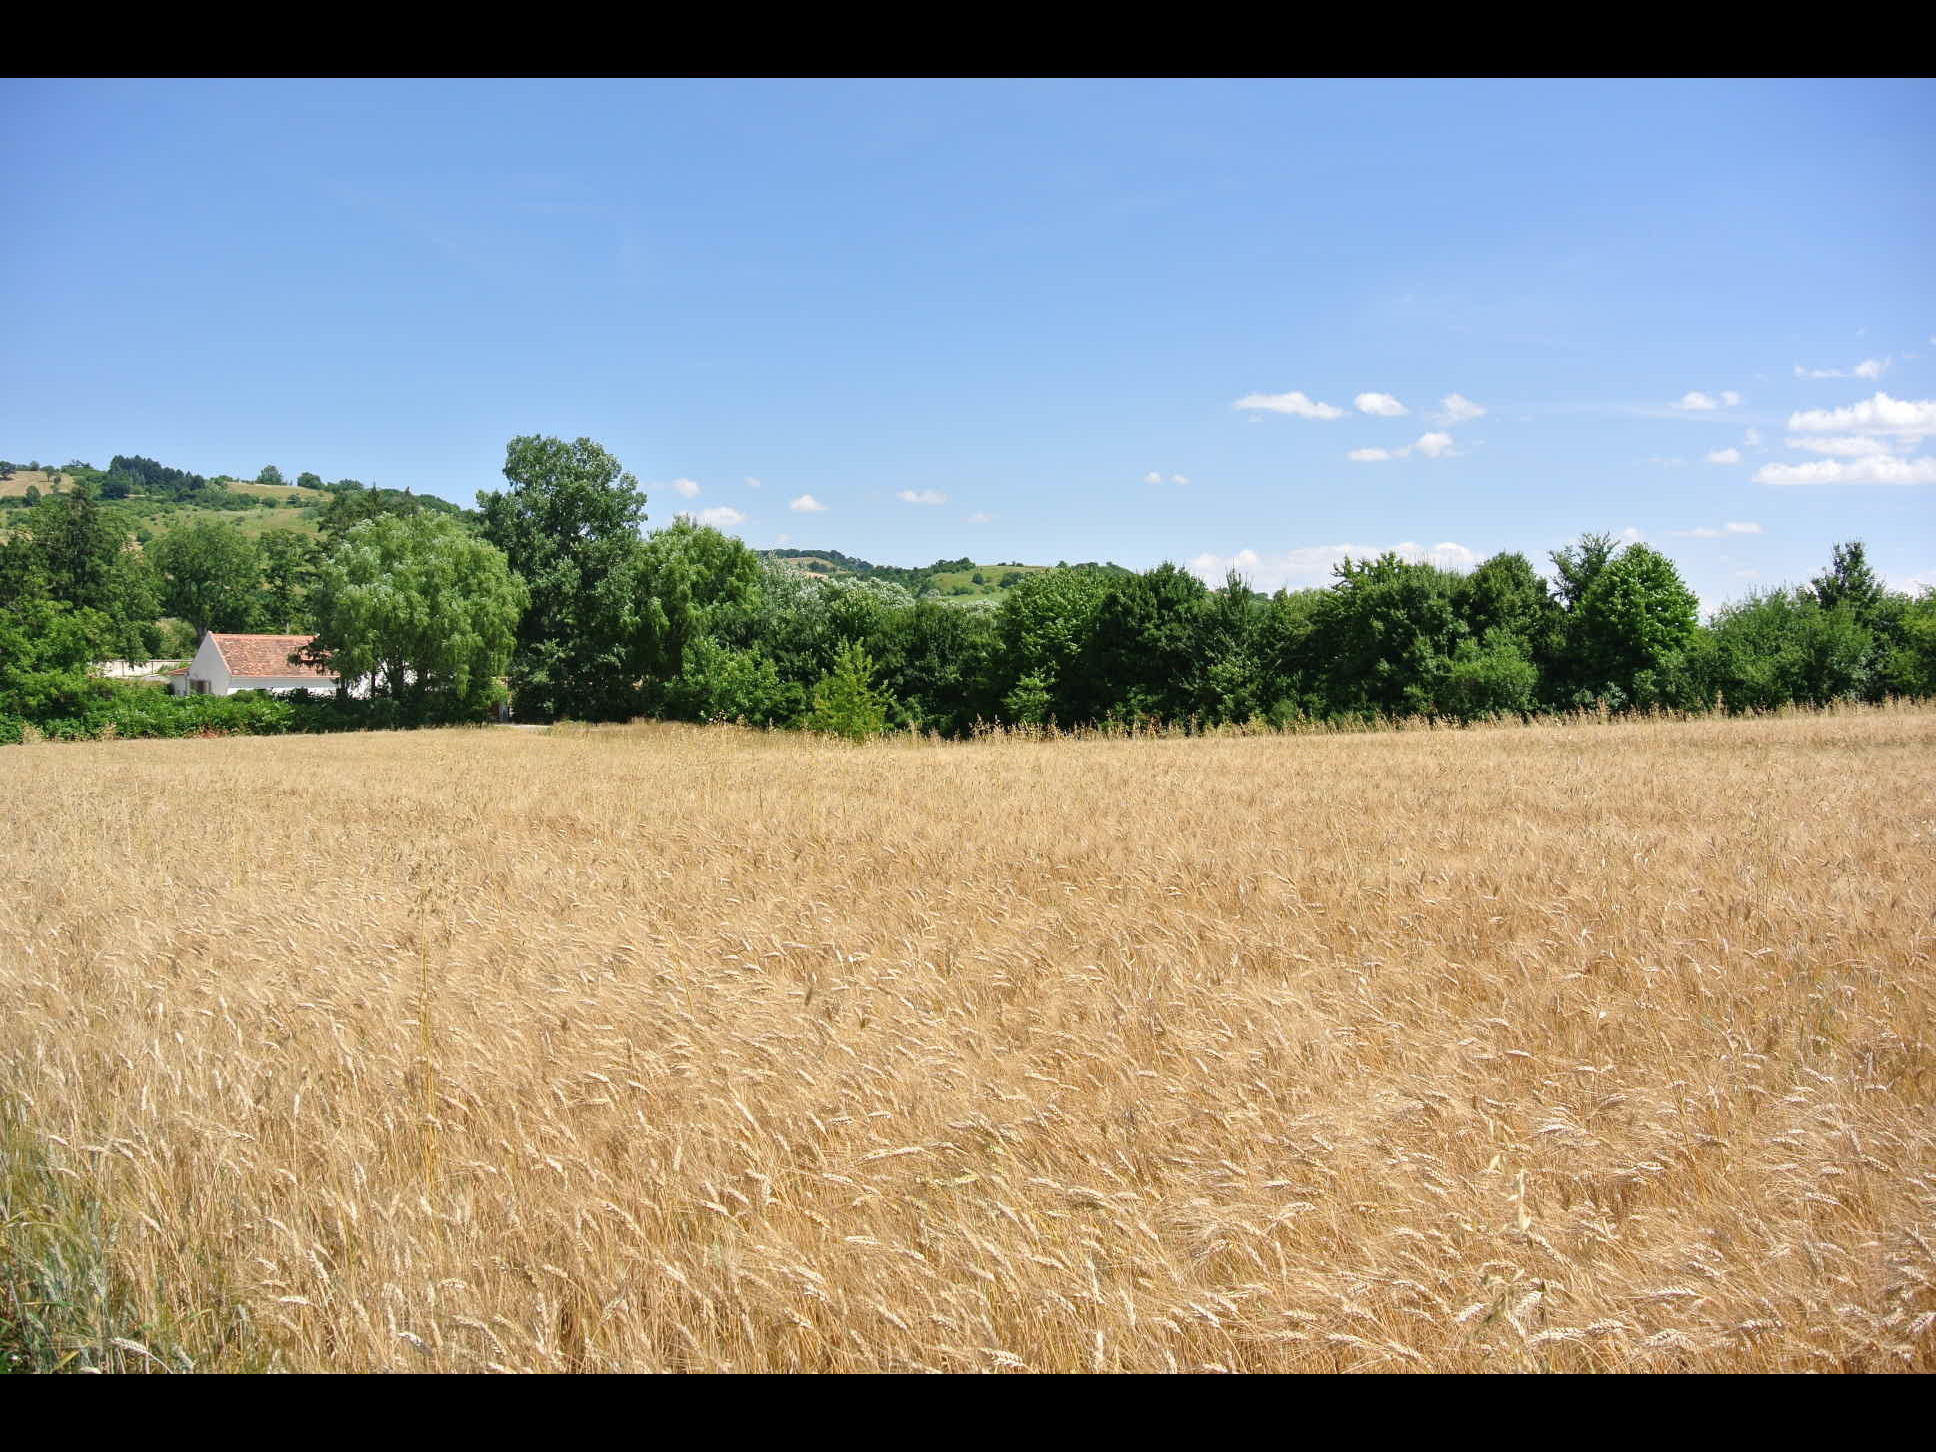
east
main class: Cropland
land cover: Maize
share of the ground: > 75 %
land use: Agriculture (excluding fallow land and kitchen gardens)
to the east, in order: Maize; Common wheat; Grass margins; Paved roads, cycling and walking lanes; Grass margins; Spruce dominated mixed woodland; Broadleaved woodland; Artificial constructions in urban areas; Broadleaved woodland; Grassland without tree/shrub cover; Fences; Broadleaved woodland
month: July
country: AT
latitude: 47.7296
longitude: 16.4174
